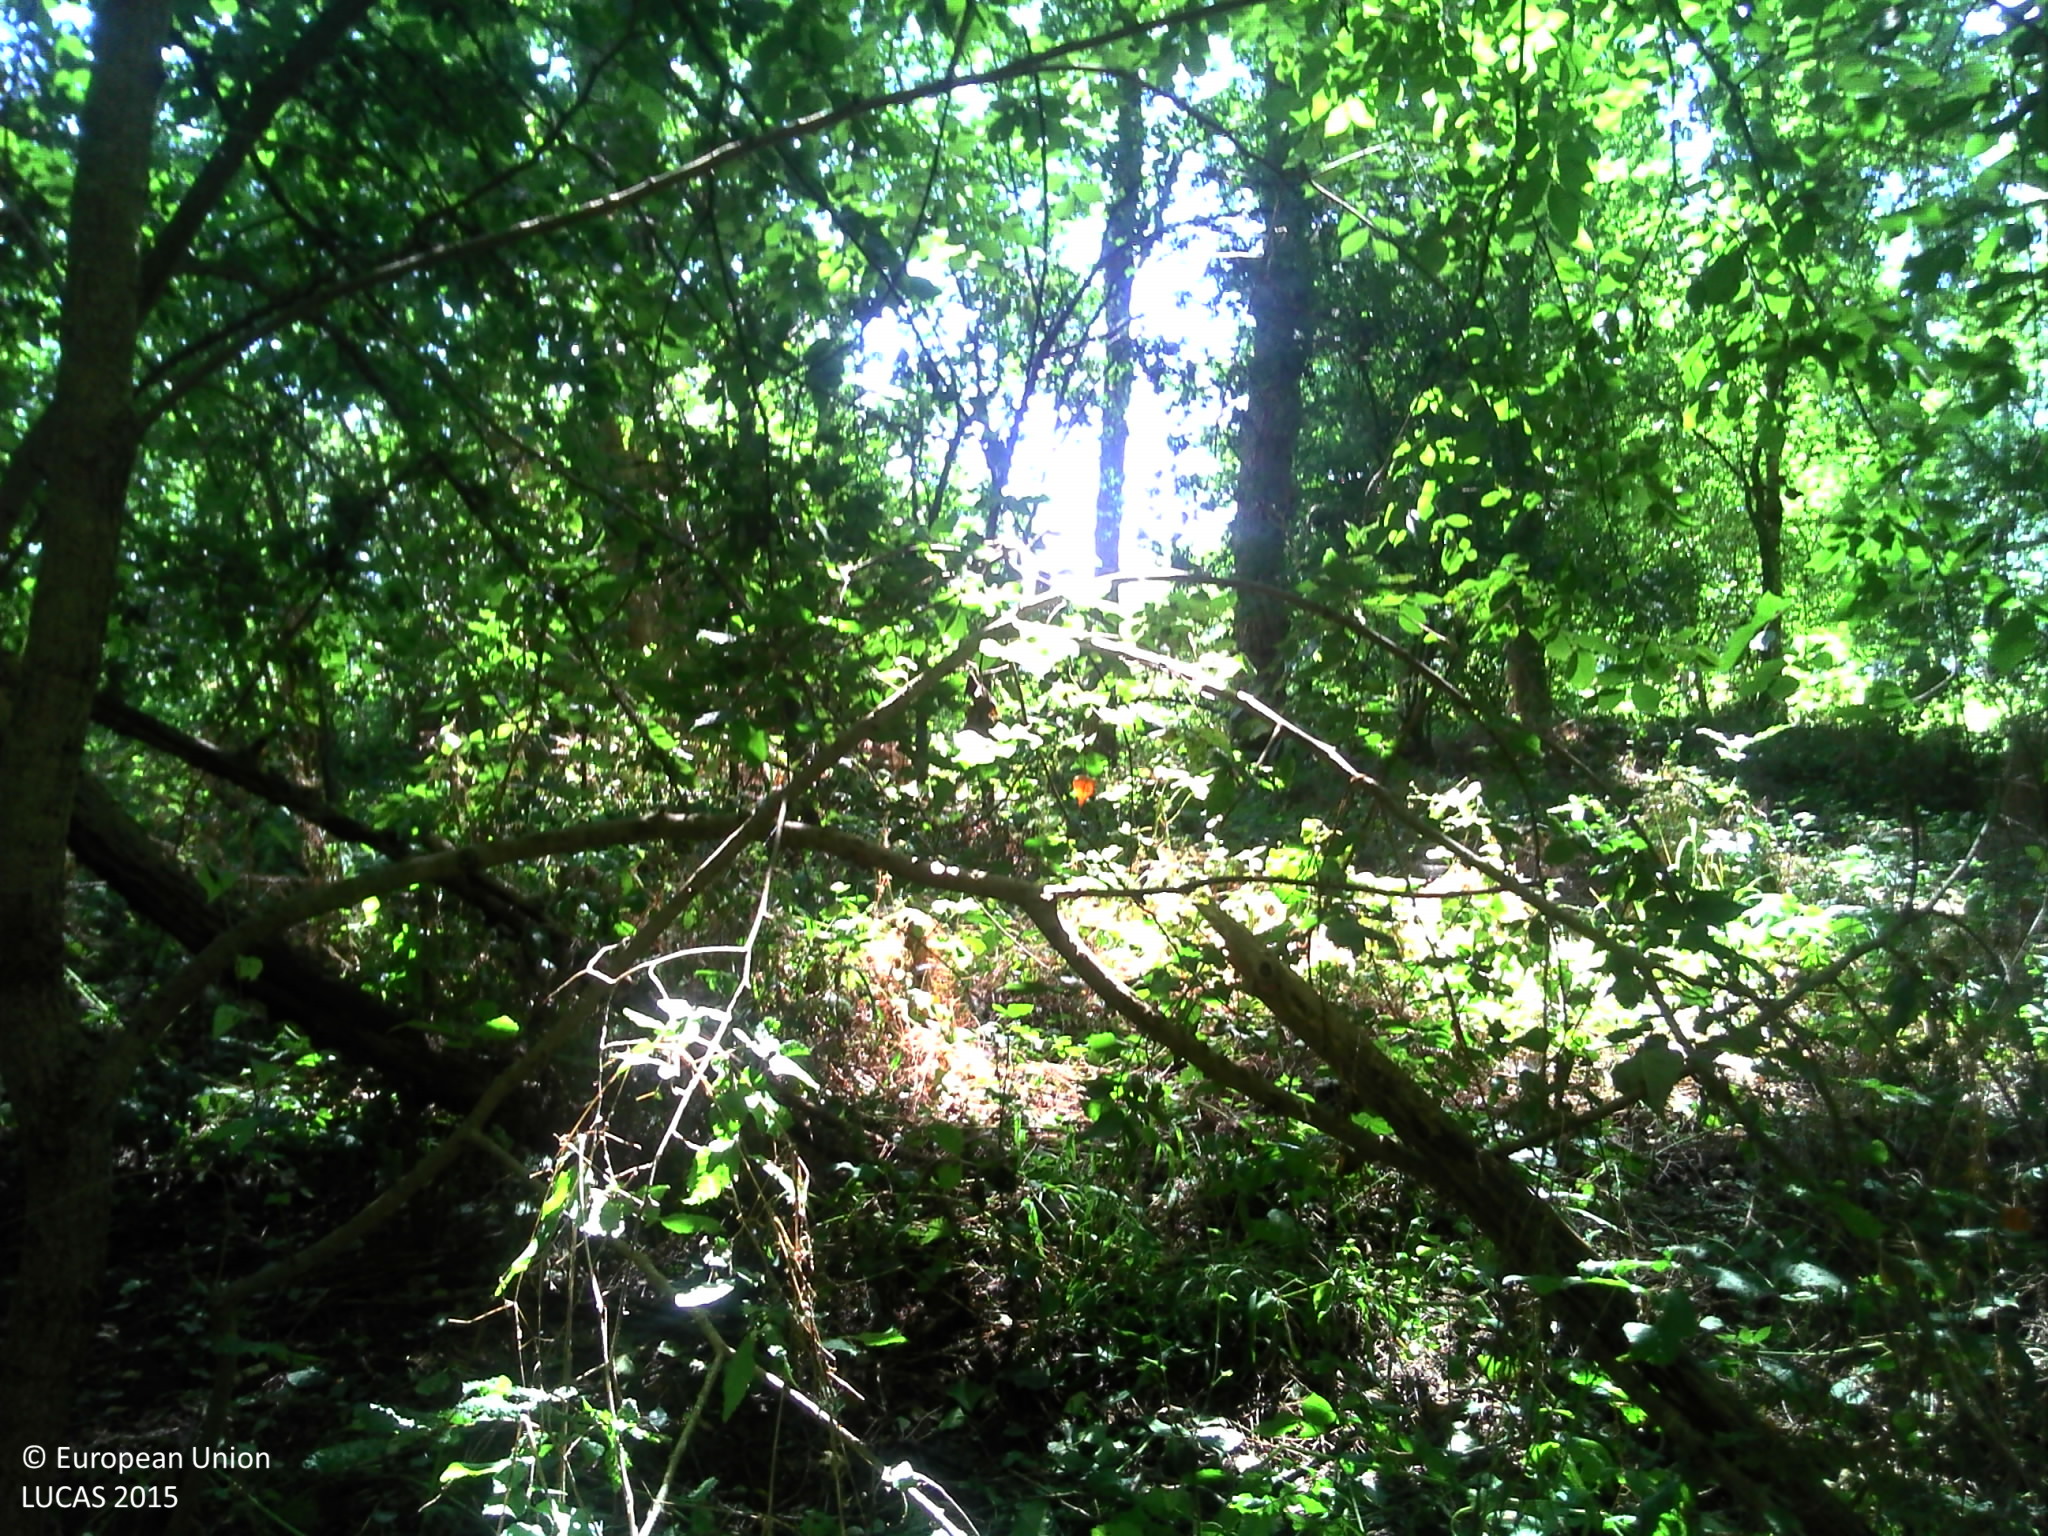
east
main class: Woodland
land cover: Broadleaved woodland
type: floodplain forest
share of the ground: > 75 %
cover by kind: broadleaved forest trees 100 %
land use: Forestry
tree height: > 5 m
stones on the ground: < 10 %
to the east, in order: Broadleaved woodland; Rivers and streams; Broadleaved woodland; Fences; Grassland without tree/shrub cover; Fences; Grassland without tree/shrub cover; Single bushes/trees; Grassland without tree/shrub cover; Fences; Grass margins; Tracks; Grass margins; Fences; Oats
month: July
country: FR
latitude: 45.3506
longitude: 3.3775
